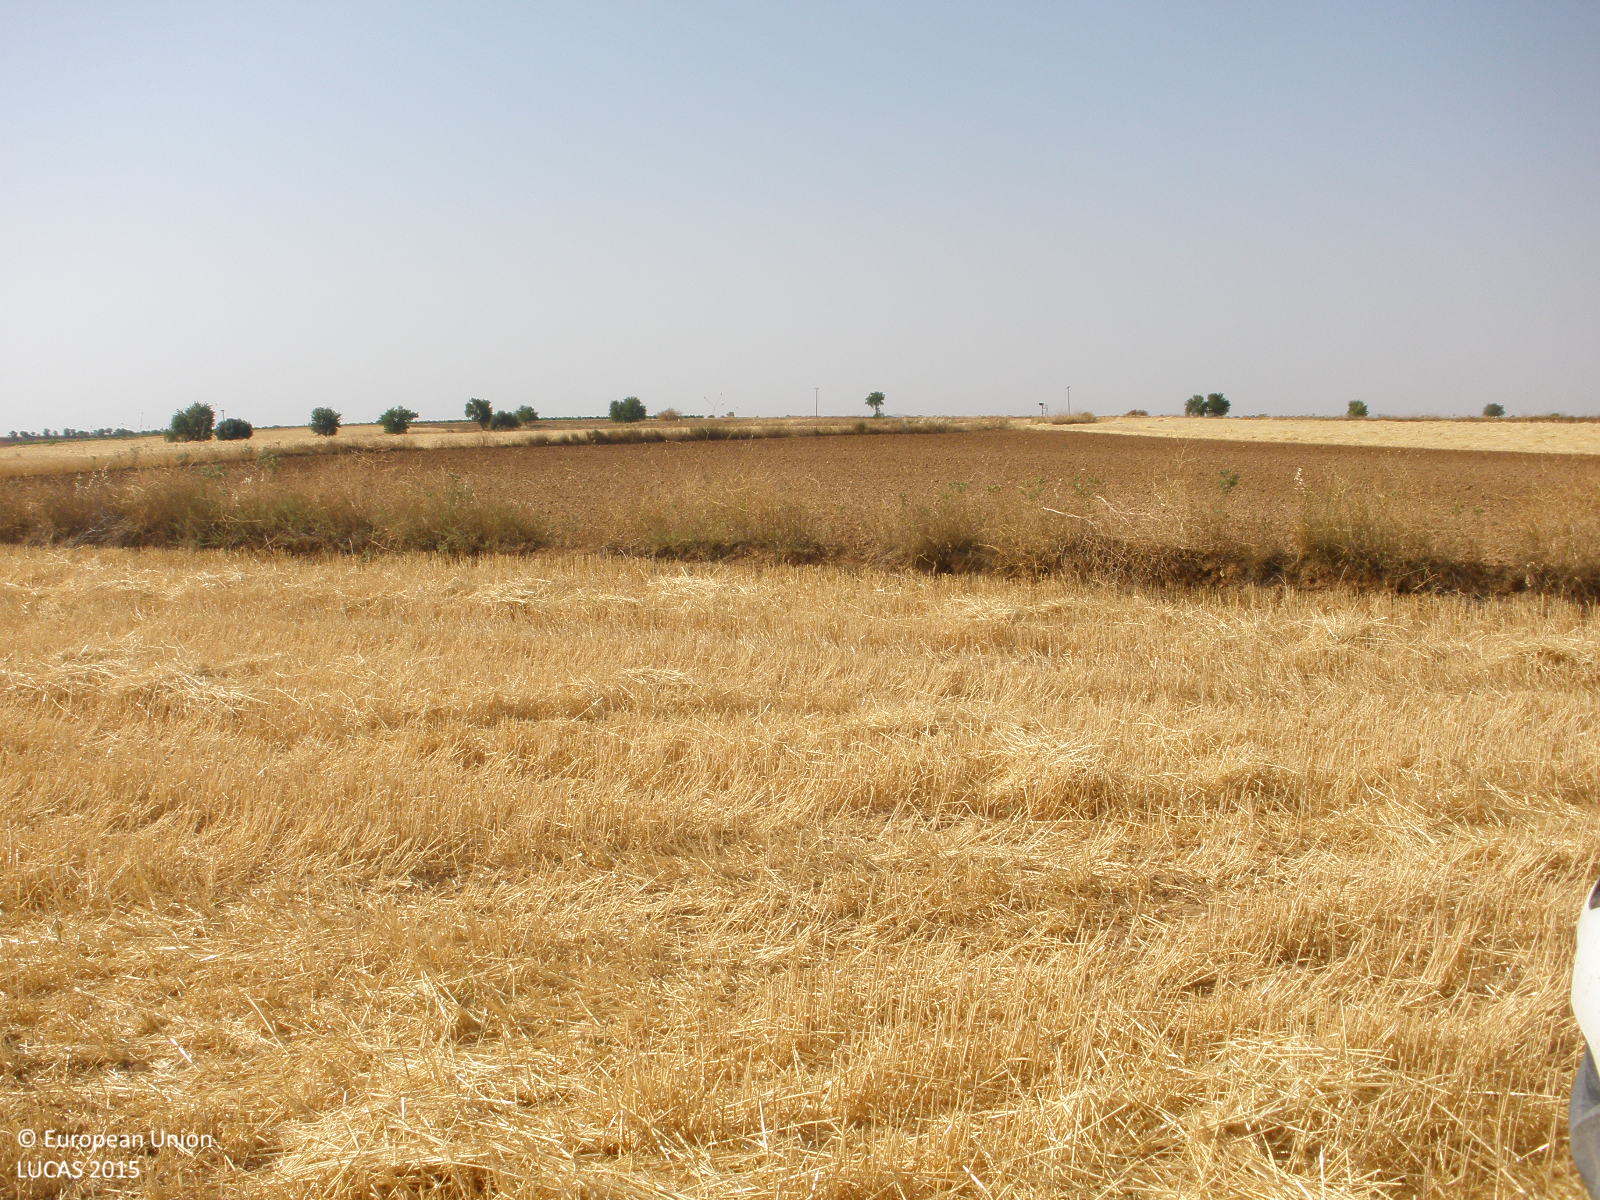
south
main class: Cropland
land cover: Common wheat
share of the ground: < 10 %
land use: Agriculture (excluding fallow land and kitchen gardens)
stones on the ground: < 10 %
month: July
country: ES
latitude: 39.9514
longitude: -3.2406
